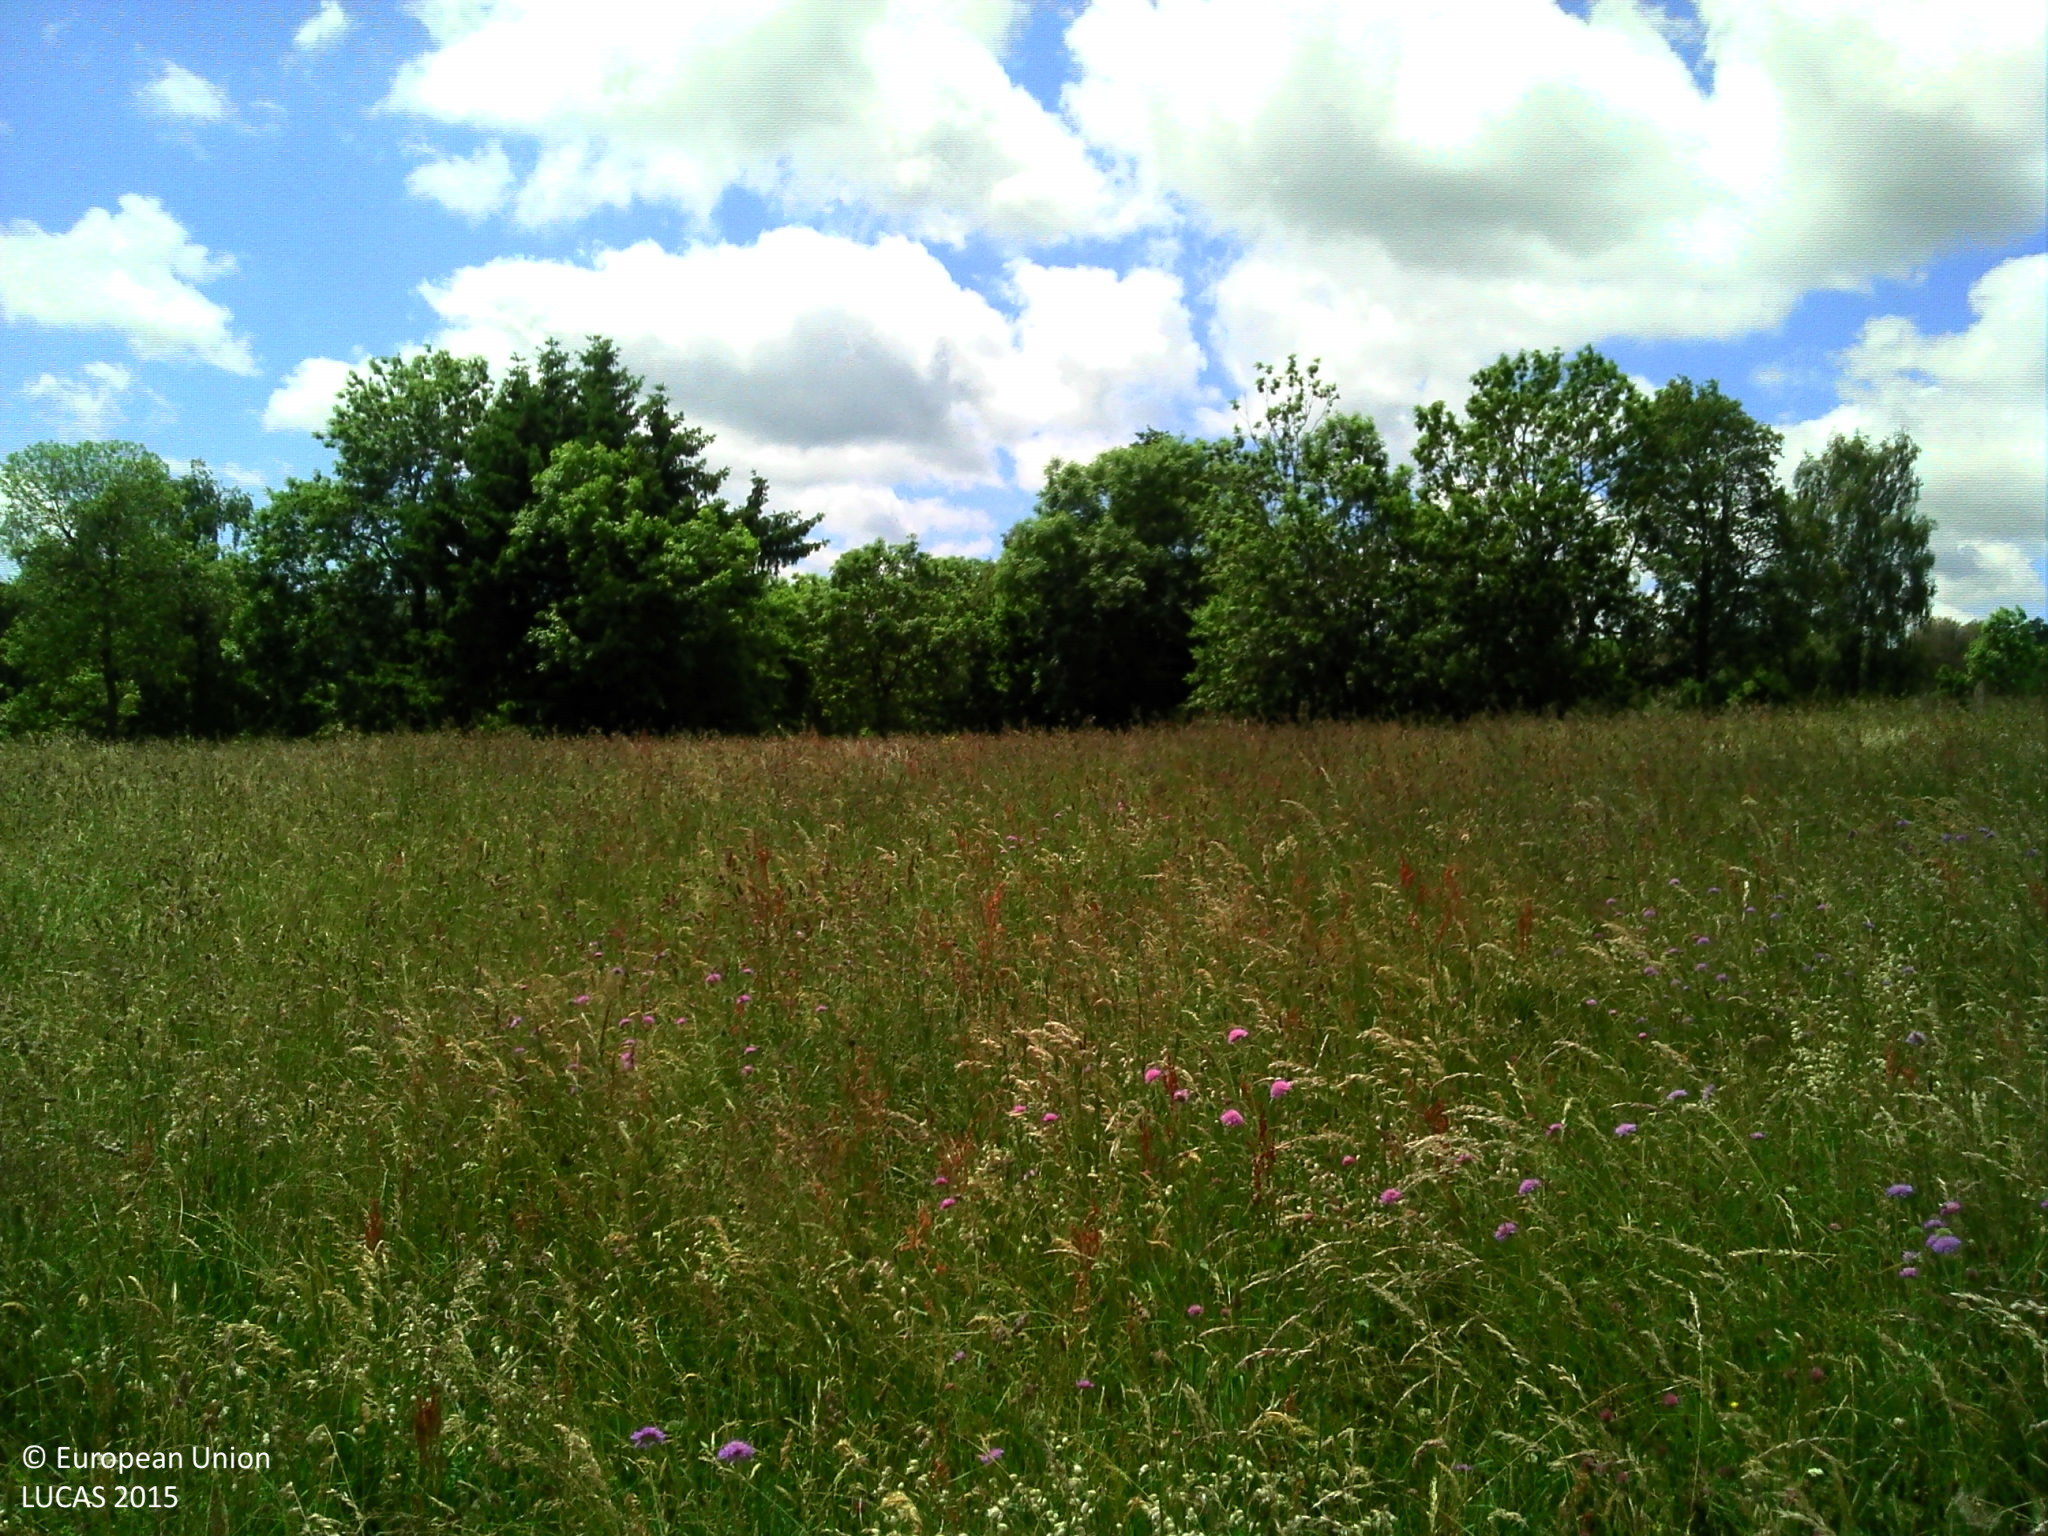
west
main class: Grassland
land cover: Grassland without tree/shrub cover
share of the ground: > 75 %
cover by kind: herbaceous plants 100 %
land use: Agriculture (excluding fallow land and kitchen gardens)
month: June
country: FR
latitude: 45.0647
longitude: 2.8767
